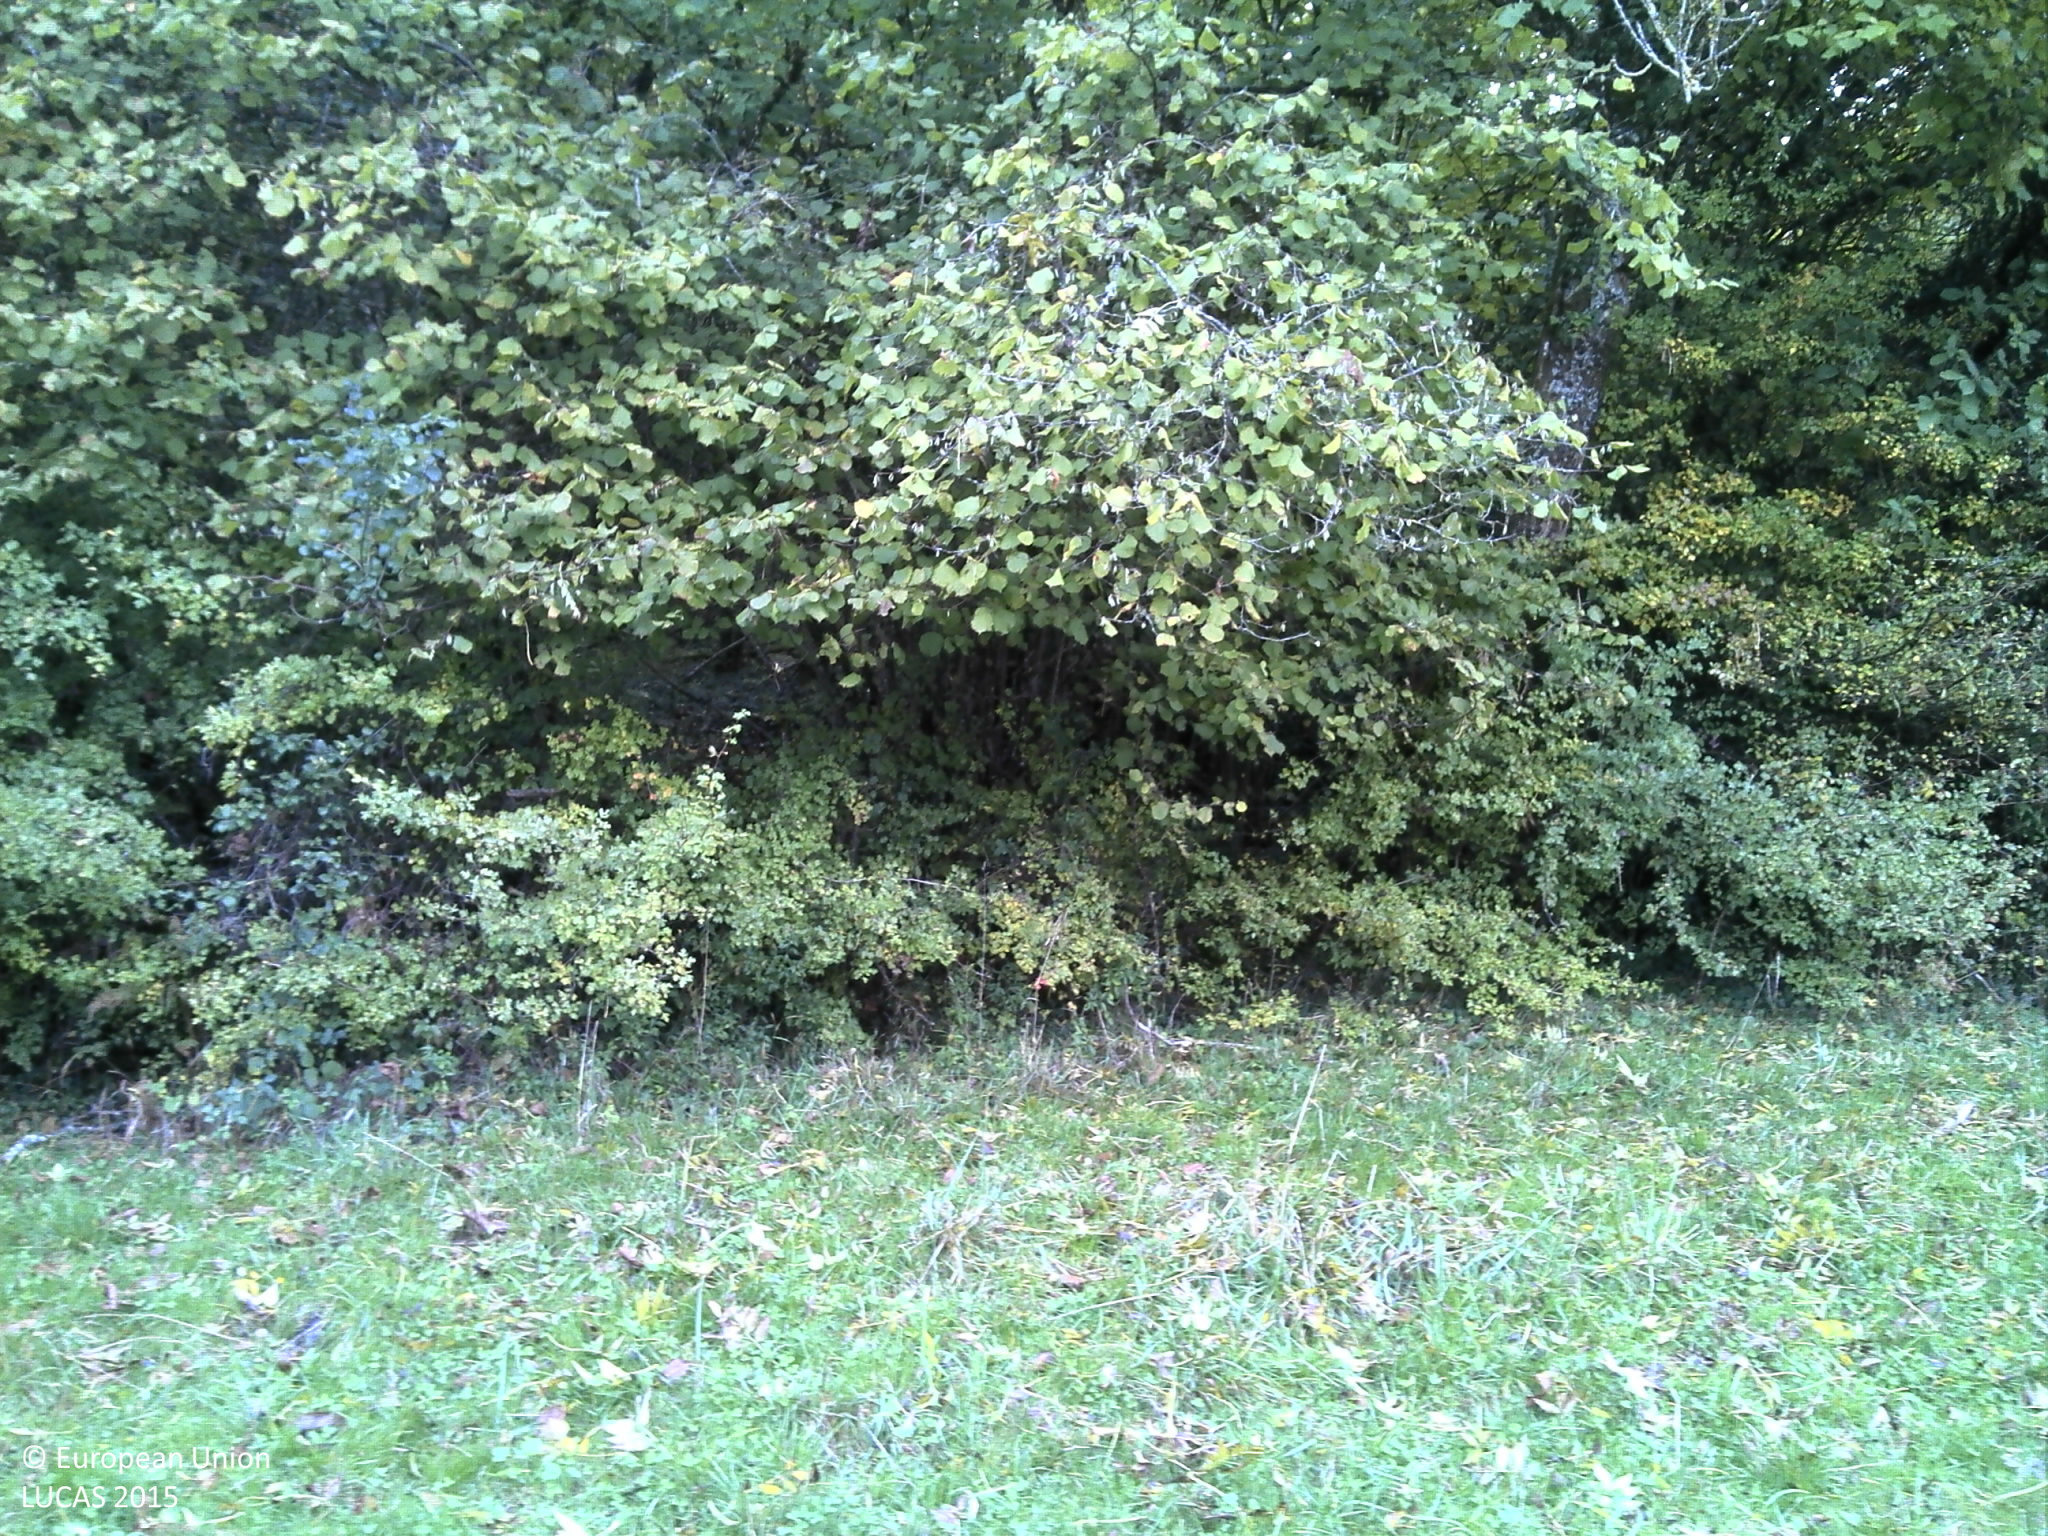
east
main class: Grassland
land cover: Grassland with sparse tree/shrub cover
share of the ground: > 75 %
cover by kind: herbaceous plants 95 %, broadleaved forest trees 5 %
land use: Agriculture (excluding fallow land and kitchen gardens)
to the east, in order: Grassland with sparse tree/shrub cover; Fences; Broadleaved woodland; Tracks; Broadleaved woodland; Dry stone walls; Fences; Grassland without tree/shrub cover; Fences; Dry stone walls; Tracks; Broadleaved woodland
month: October
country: FR
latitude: 46.1050
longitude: 5.3330
